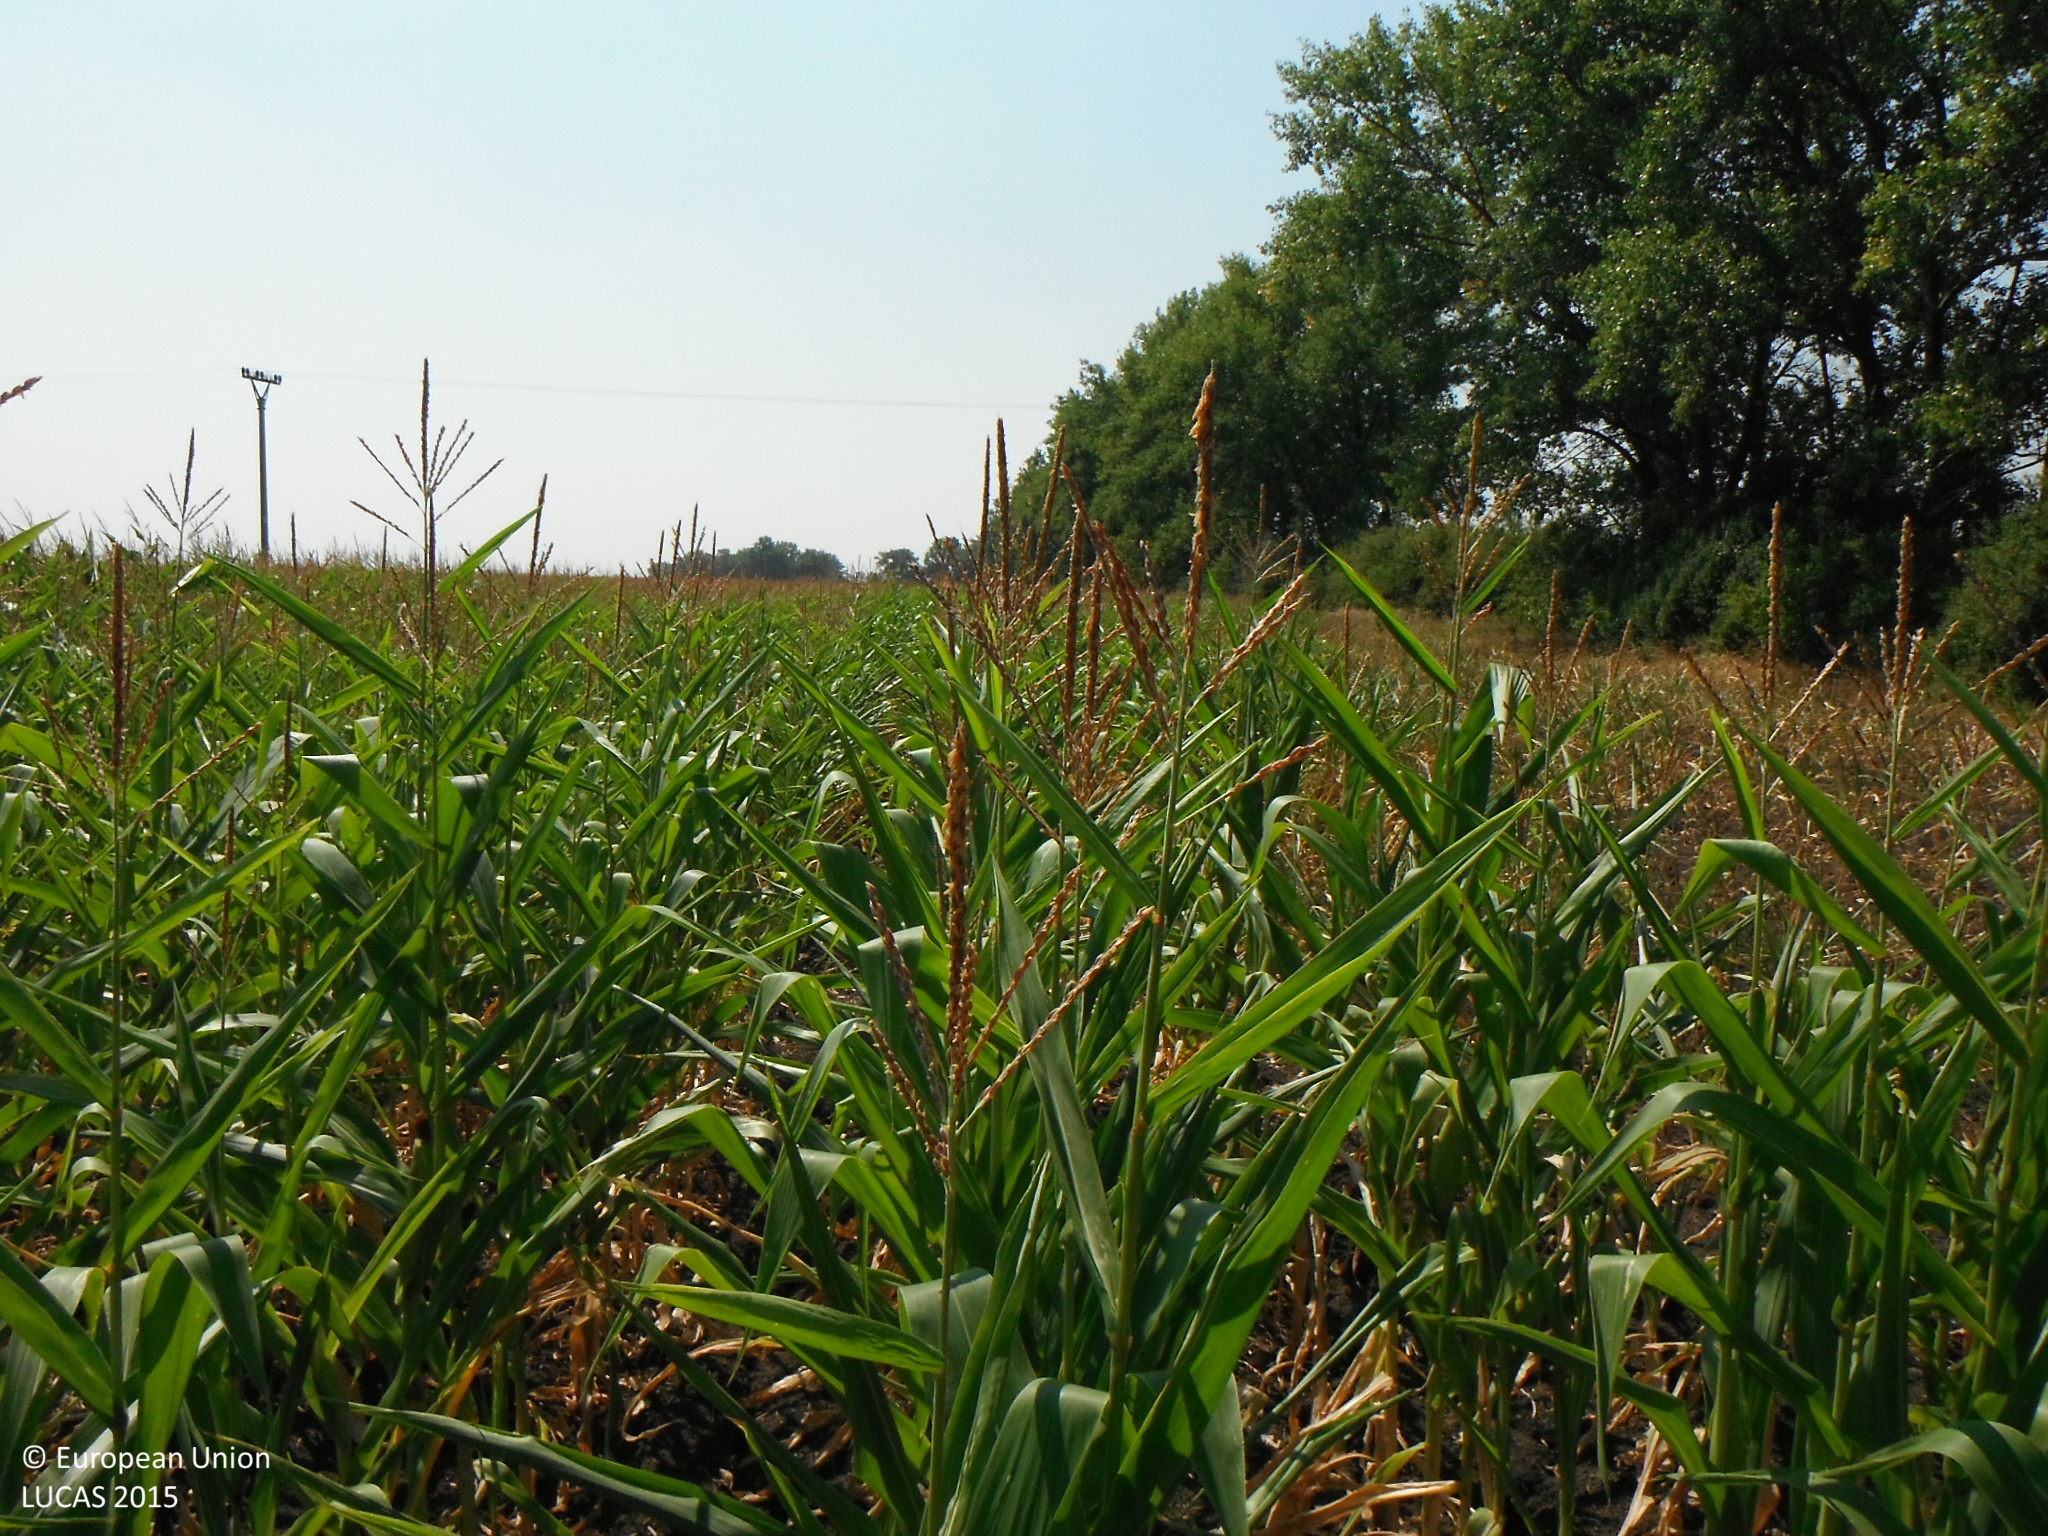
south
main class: Cropland
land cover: Maize
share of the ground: > 75 %
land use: Agriculture (excluding fallow land and kitchen gardens)
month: August
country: SK
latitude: 48.0773
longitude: 18.2421
